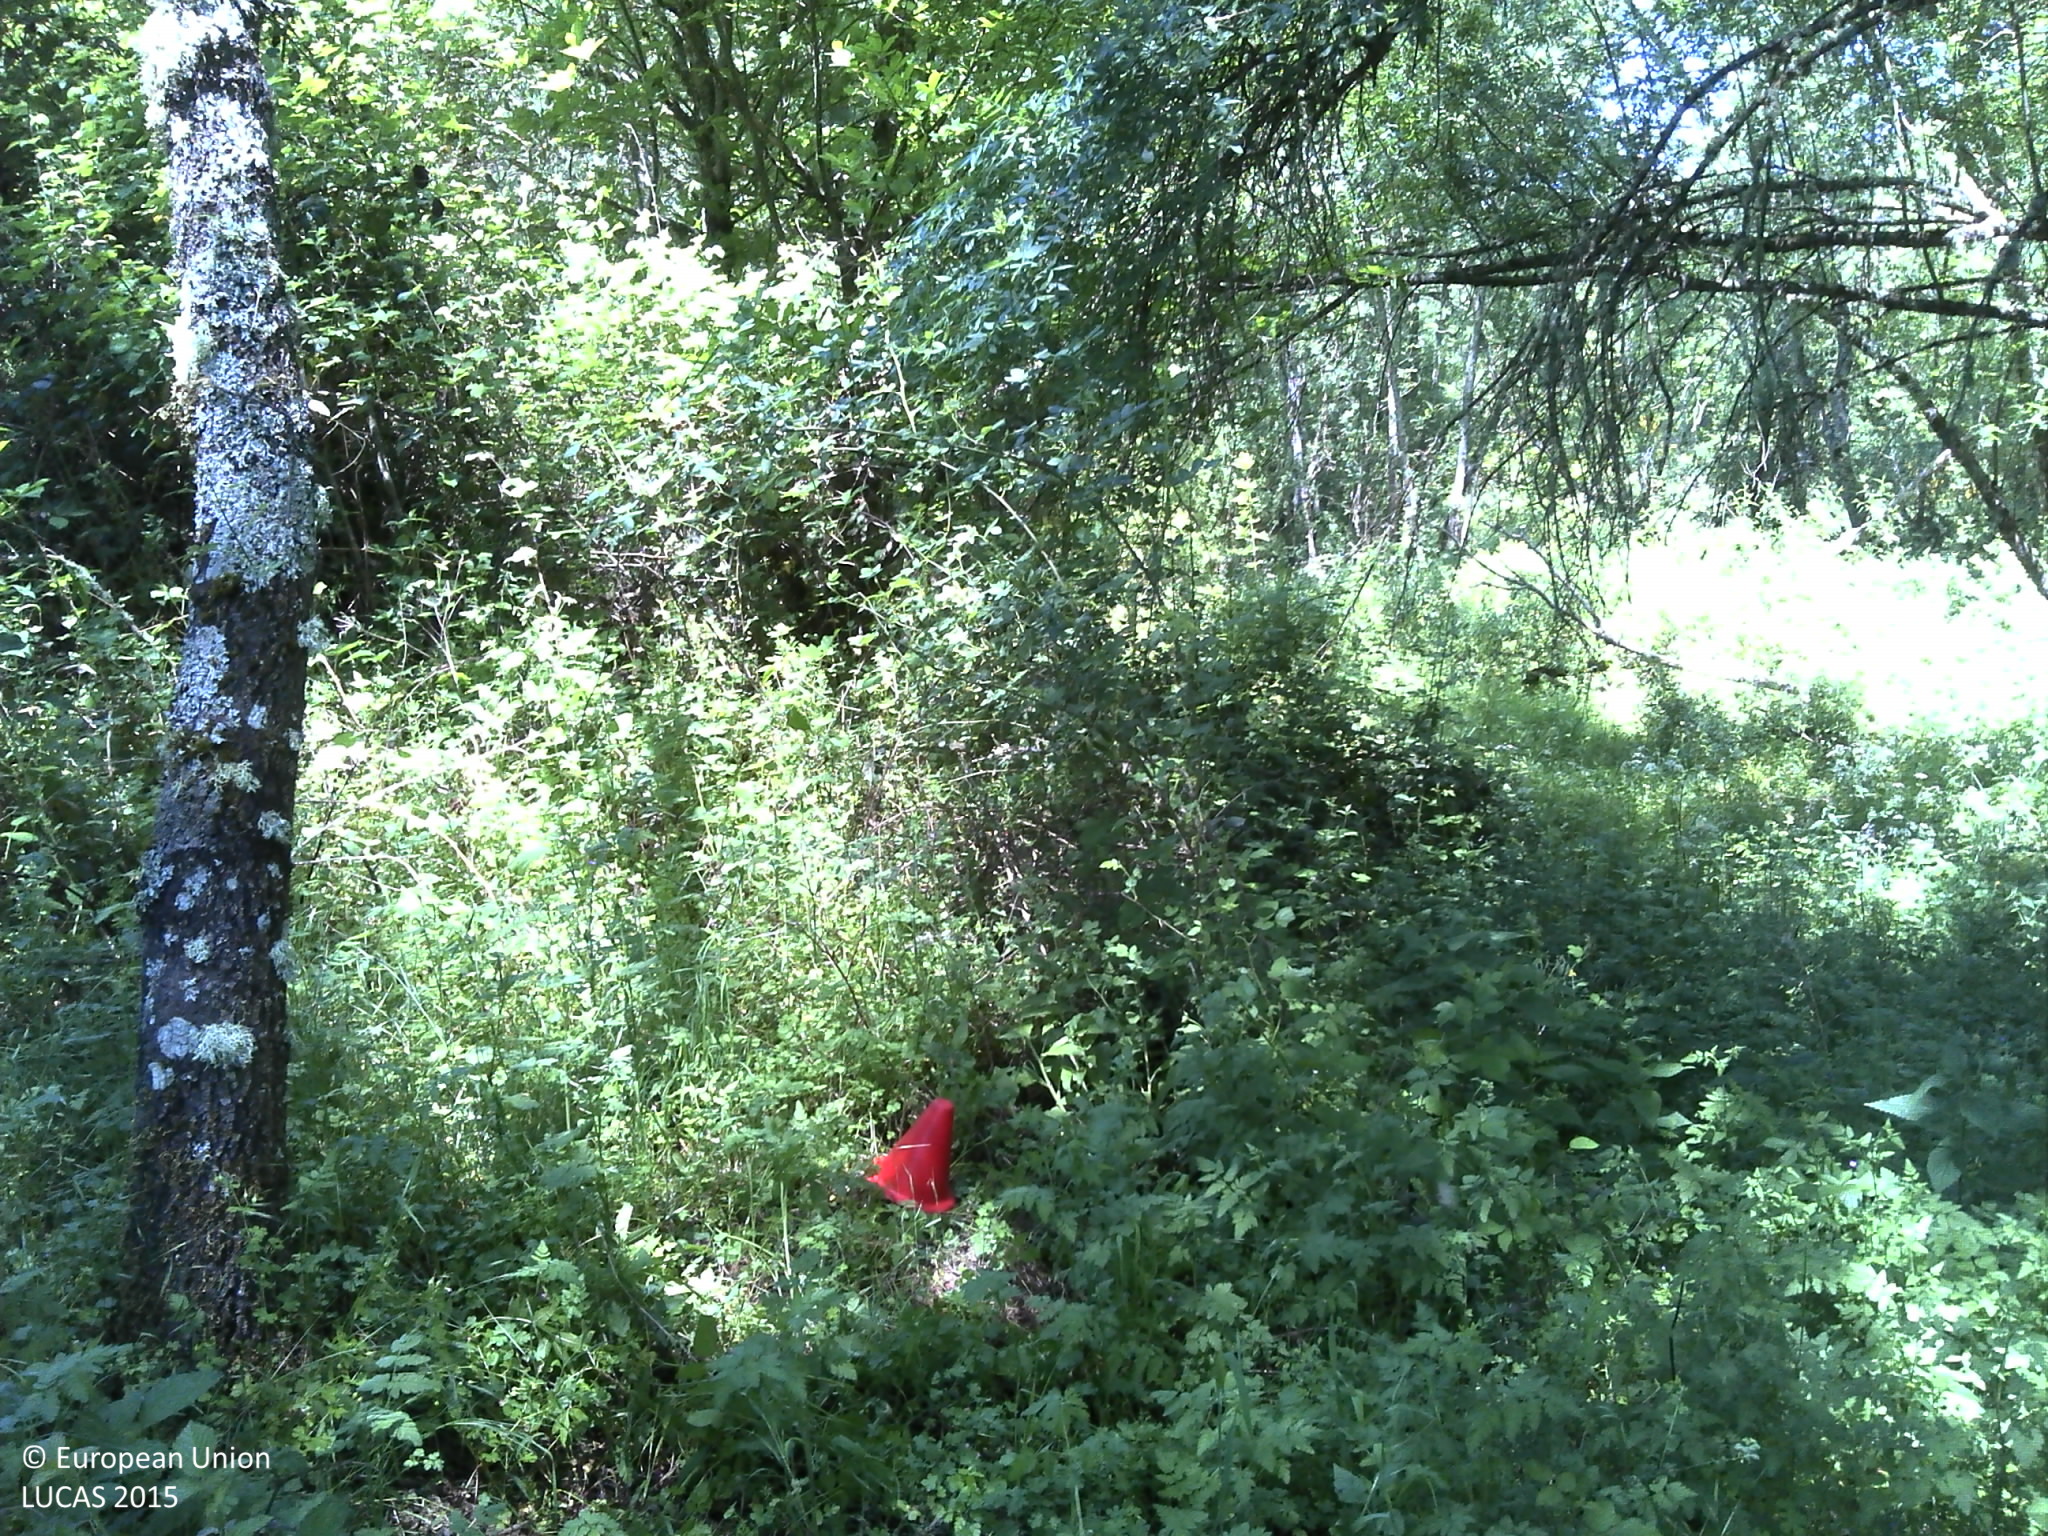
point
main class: Woodland
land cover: Broadleaved woodland
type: mesophytic deciduous forest
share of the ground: > 75 %
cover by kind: broadleaved forest trees 70 %, shrubs 25 %, herbaceous plants 5 %
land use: Forestry
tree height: > 5 m
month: May
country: PT
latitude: 41.6328
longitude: -7.4991
